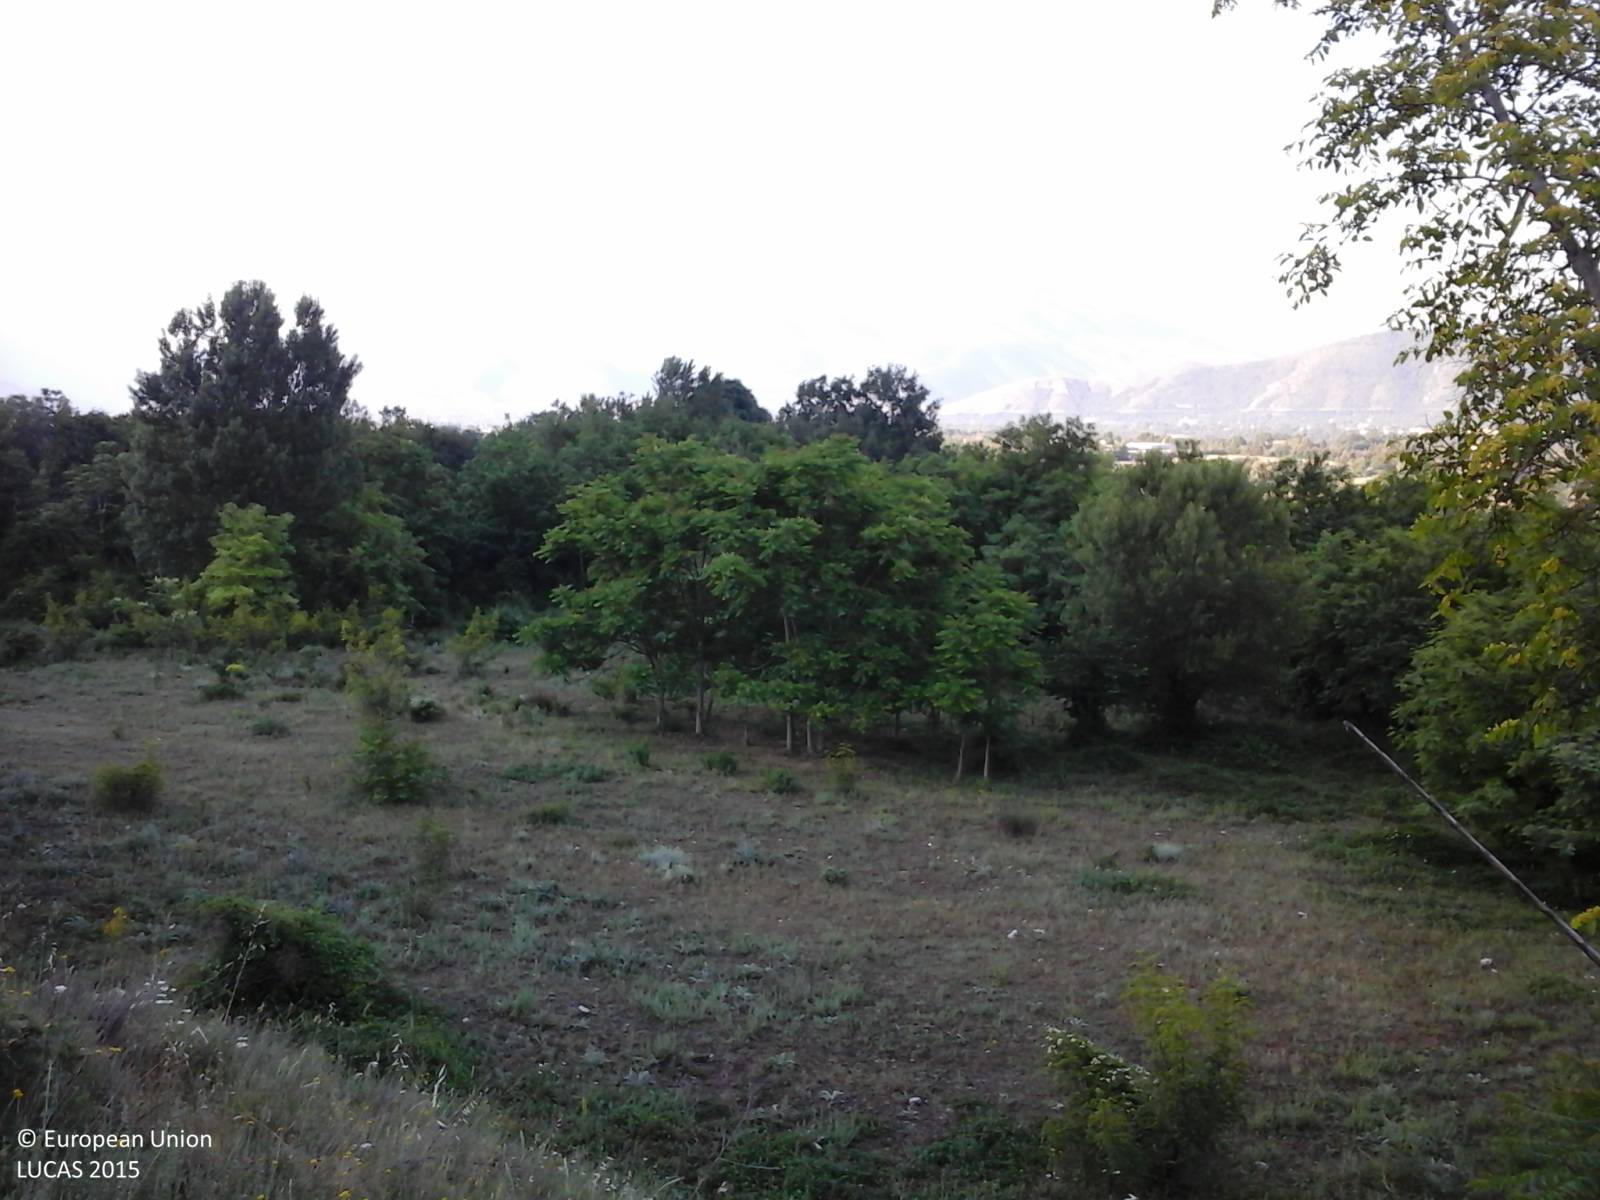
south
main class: Shrubland
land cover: Shrubland with sparse tree cover
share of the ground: > 75 %
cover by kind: herbaceous plants 70 %, shrubs 20 %, broadleaved forest trees 5 %, unconsolidated bare surface 5 %
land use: Agriculture (excluding fallow land and kitchen gardens)
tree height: < 5 m
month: June
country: IT
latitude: 42.1090
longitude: 13.8934
